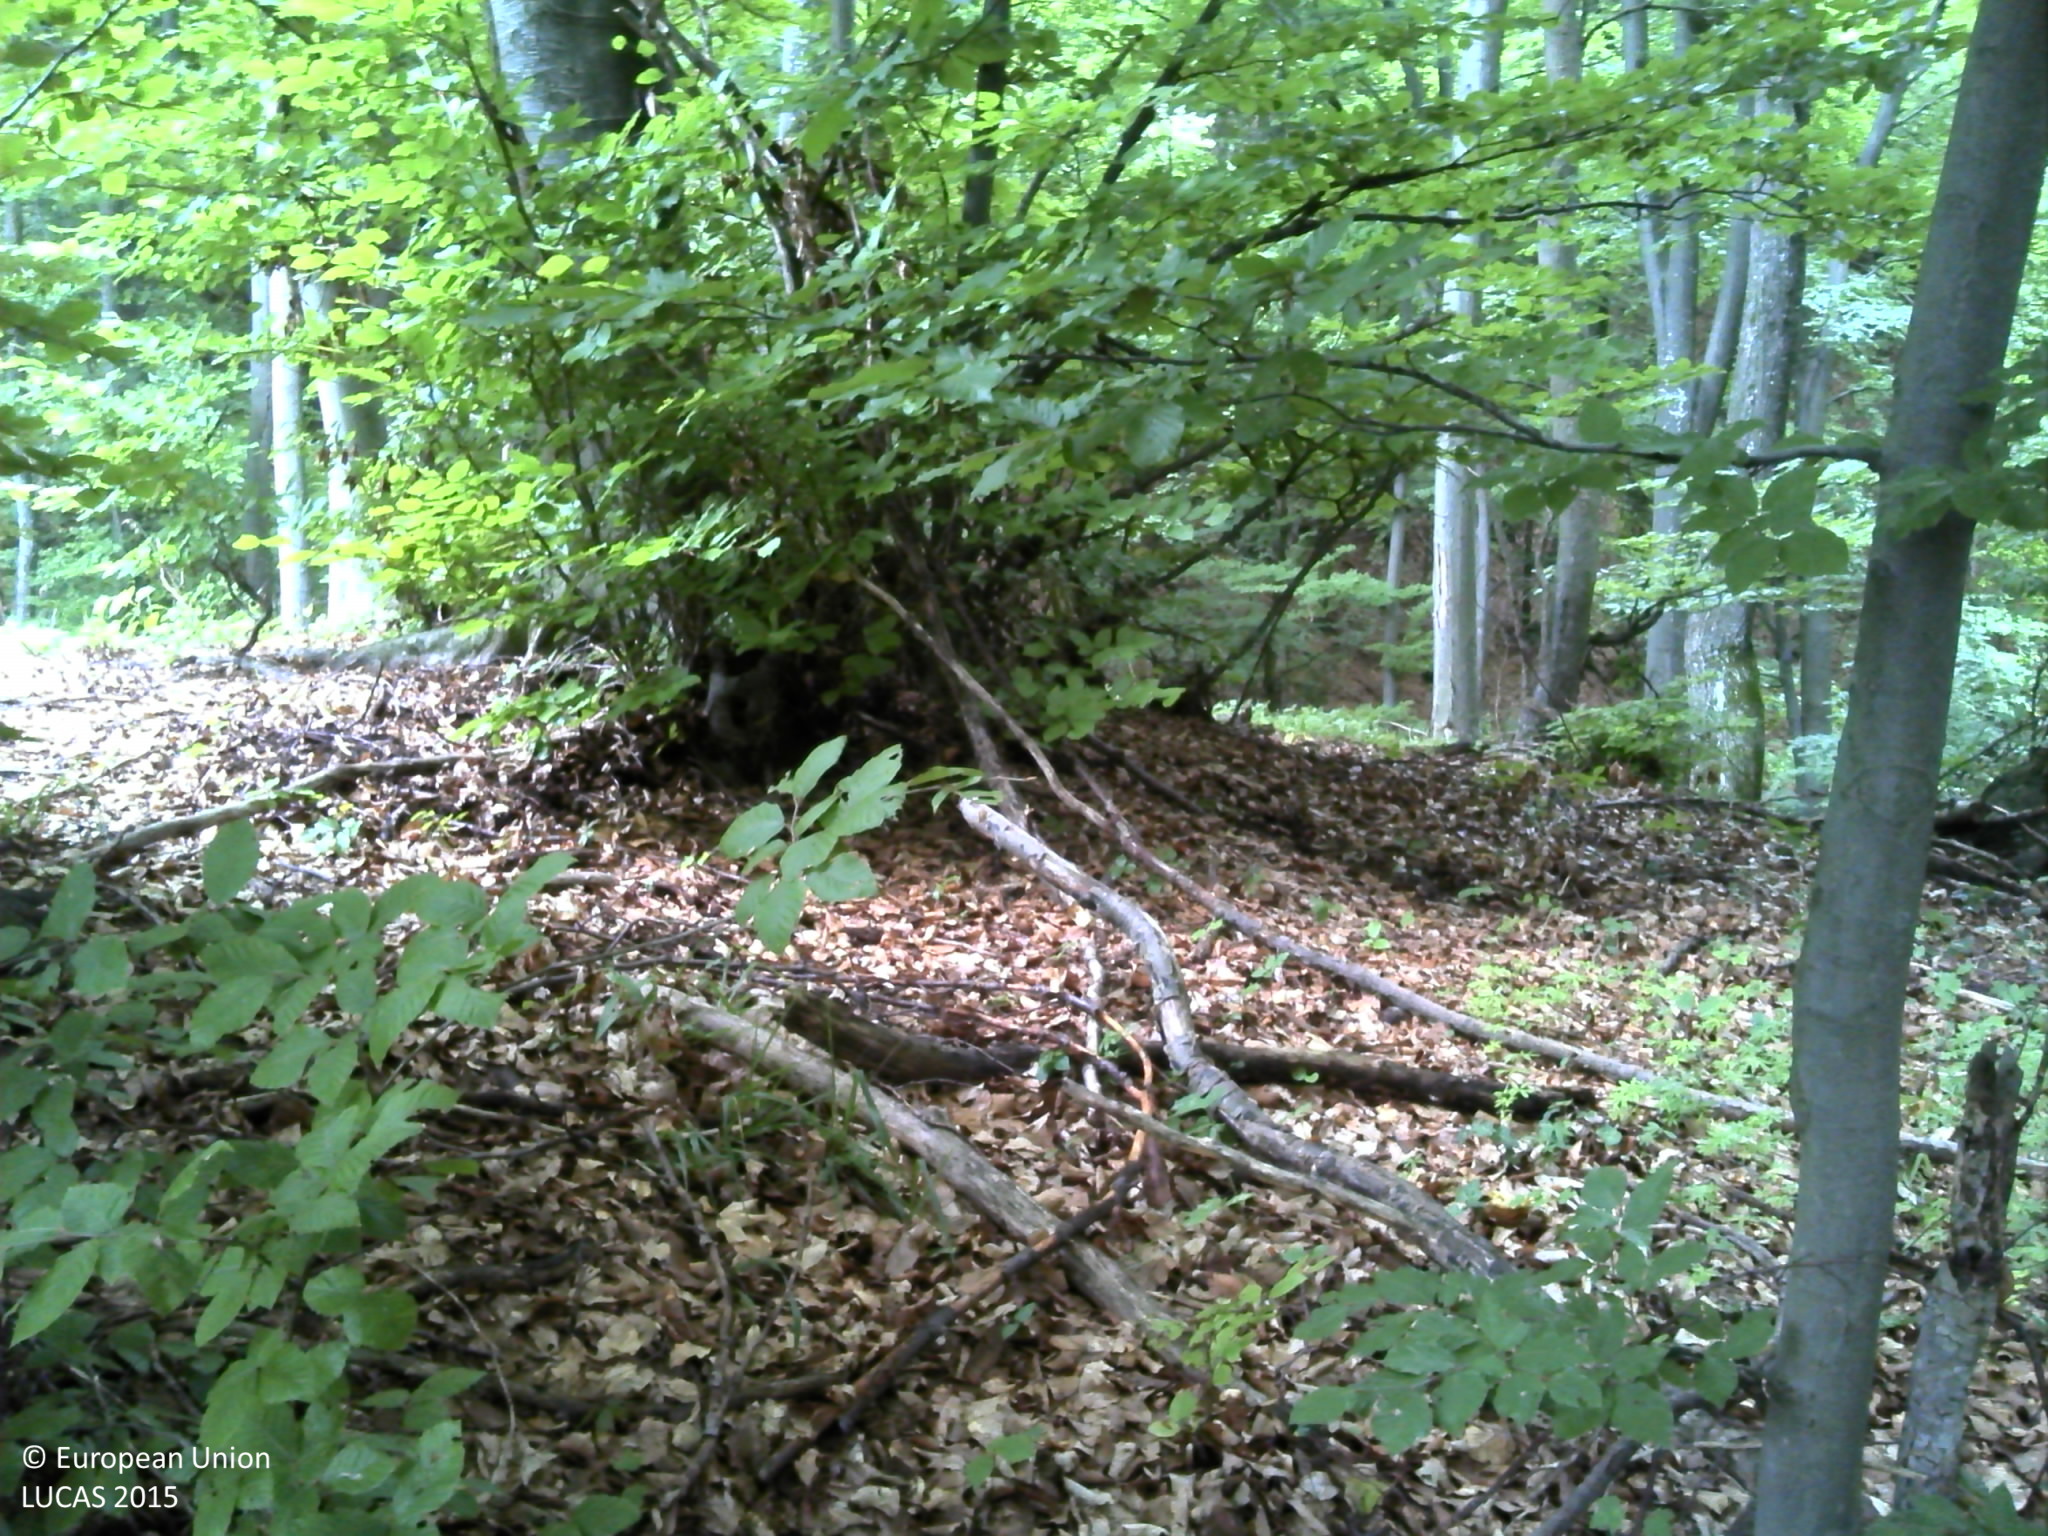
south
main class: Woodland
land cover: Broadleaved woodland
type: beech forest
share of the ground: > 75 %
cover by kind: broadleaved forest trees 100 %
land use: Forestry
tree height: > 5 m
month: July
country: HR
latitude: 45.6386
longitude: 17.4556
